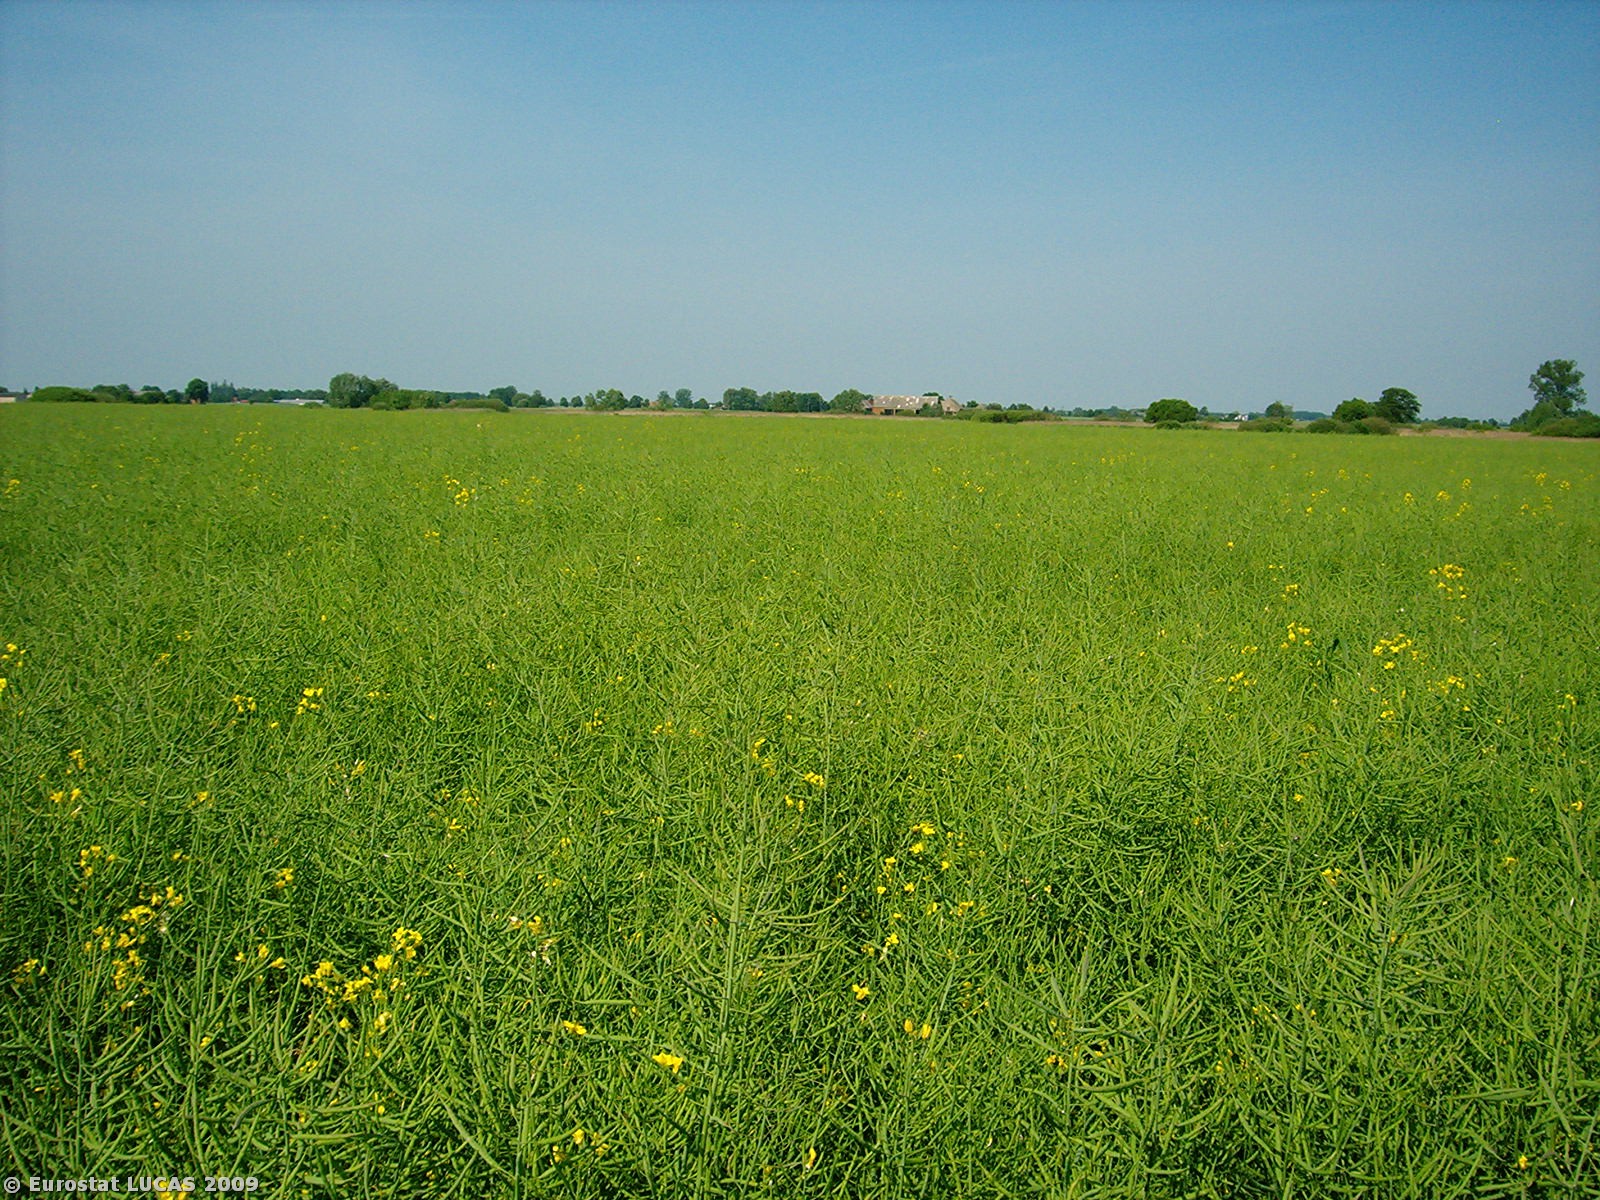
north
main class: Cropland
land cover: Rape and turnip rape
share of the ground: > 75 %
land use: Agriculture (excluding fallow land and kitchen gardens)
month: May
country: PL
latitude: 52.4599
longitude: 16.3501
